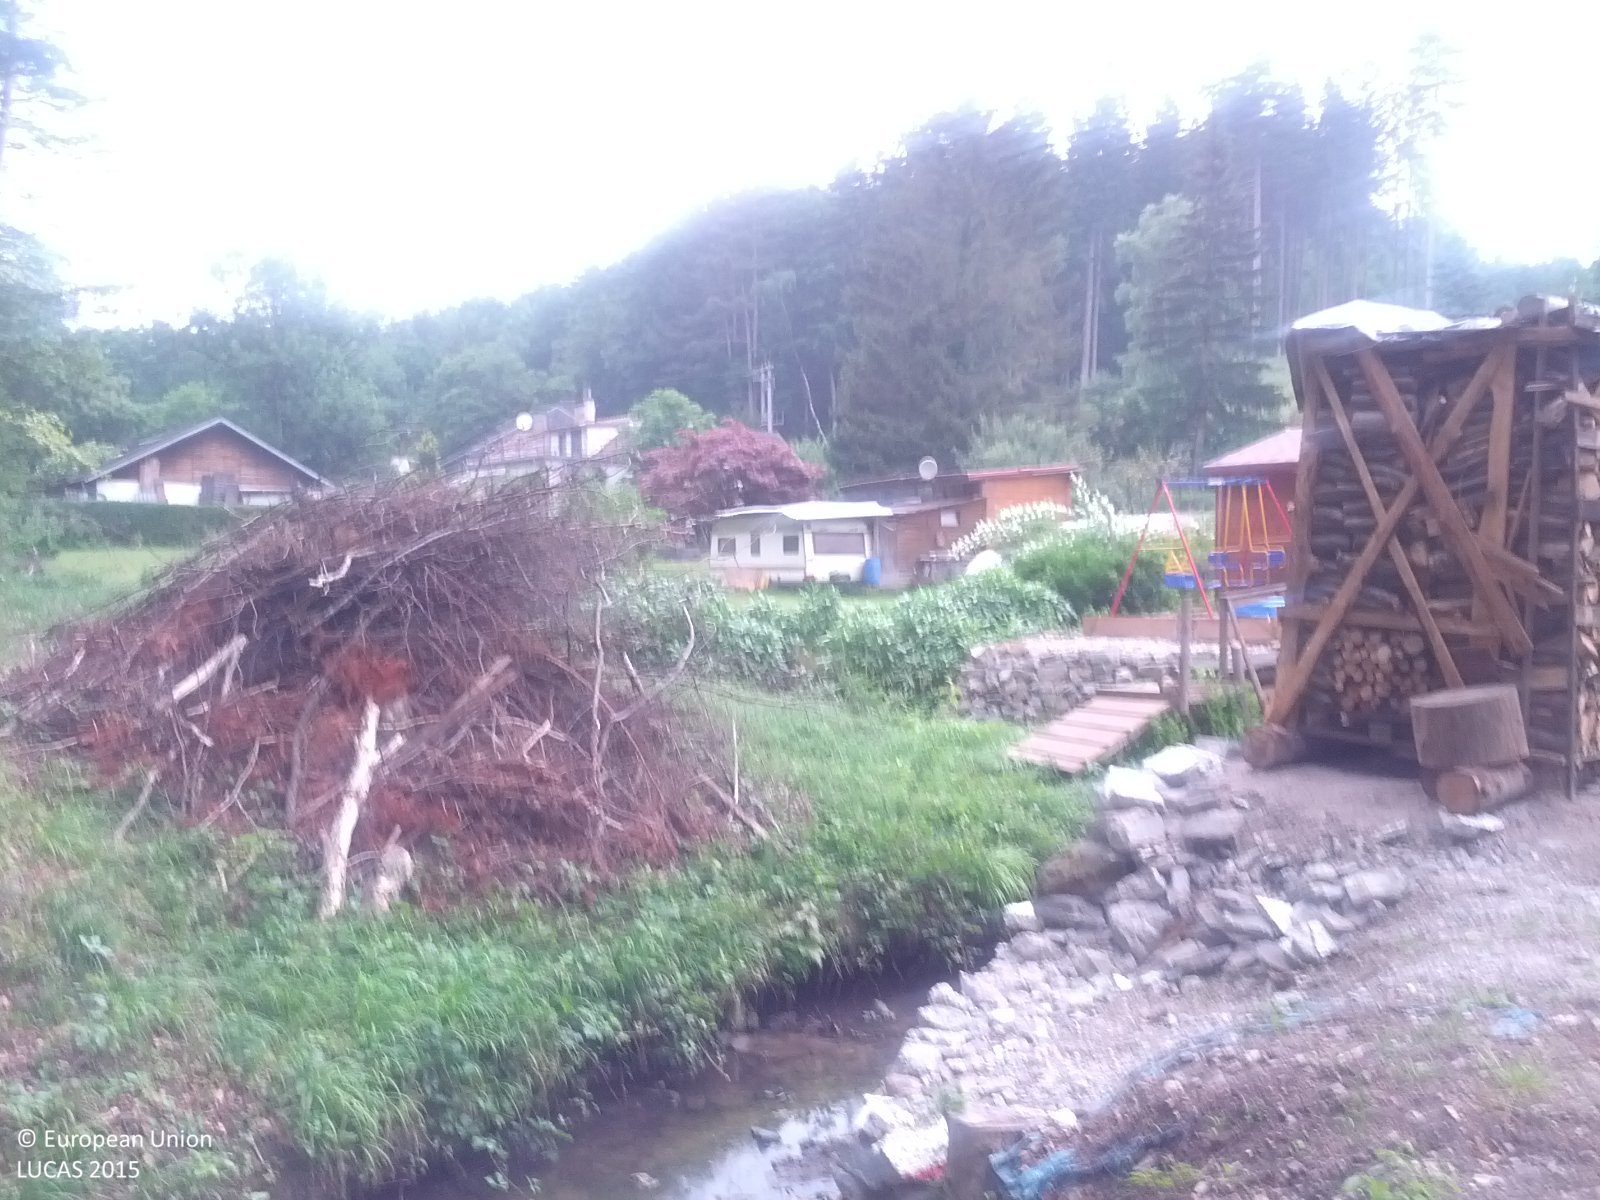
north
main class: Woodland
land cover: Spruce dominated mixed woodland
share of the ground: > 75 %
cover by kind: unconsolidated bare surface 50 %, herbaceous plants 25 %, coniferous forest trees 10 %, broadleaved forest trees 10 %, shrubs 5 %
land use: Forestry
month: June
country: AT
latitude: 48.2005
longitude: 16.0720
